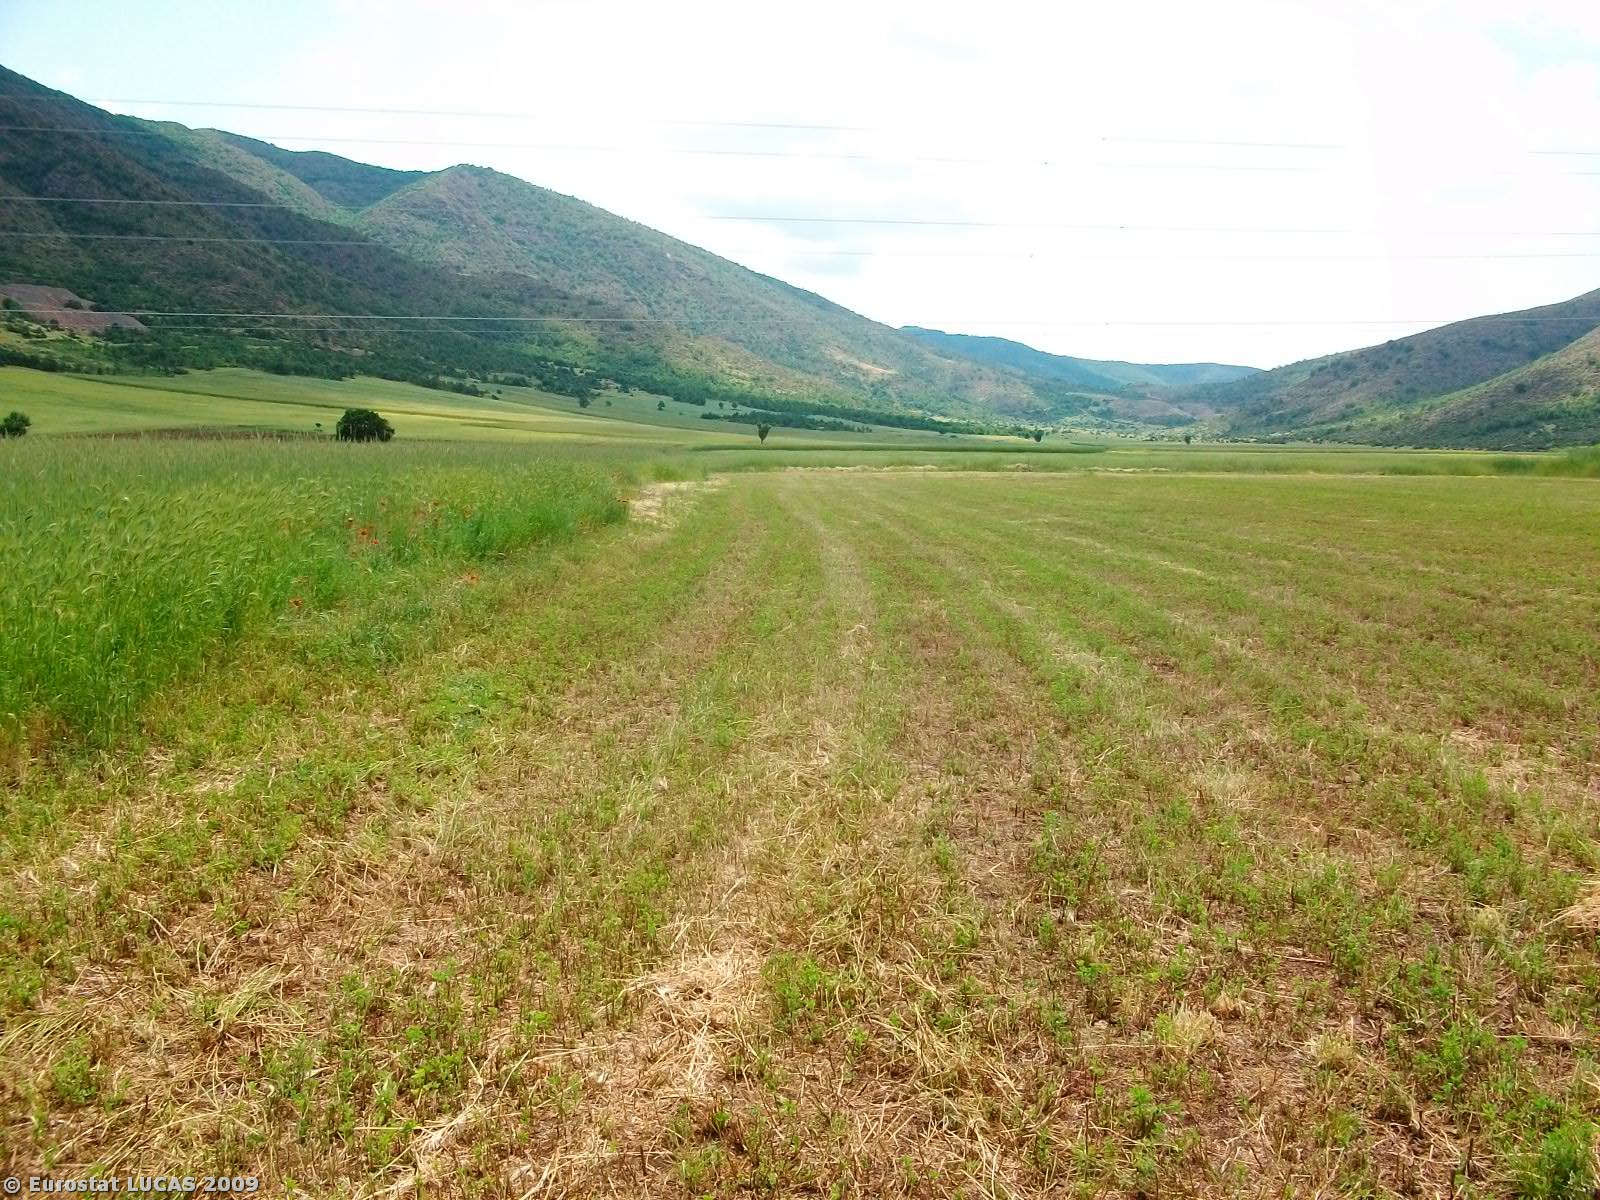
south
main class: Cropland
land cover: Lucerne
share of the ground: 25 - 50 %
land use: Agriculture (excluding fallow land and kitchen gardens)
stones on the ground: 10 - 25 %
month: May
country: GR
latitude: 40.1114
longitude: 21.7098
